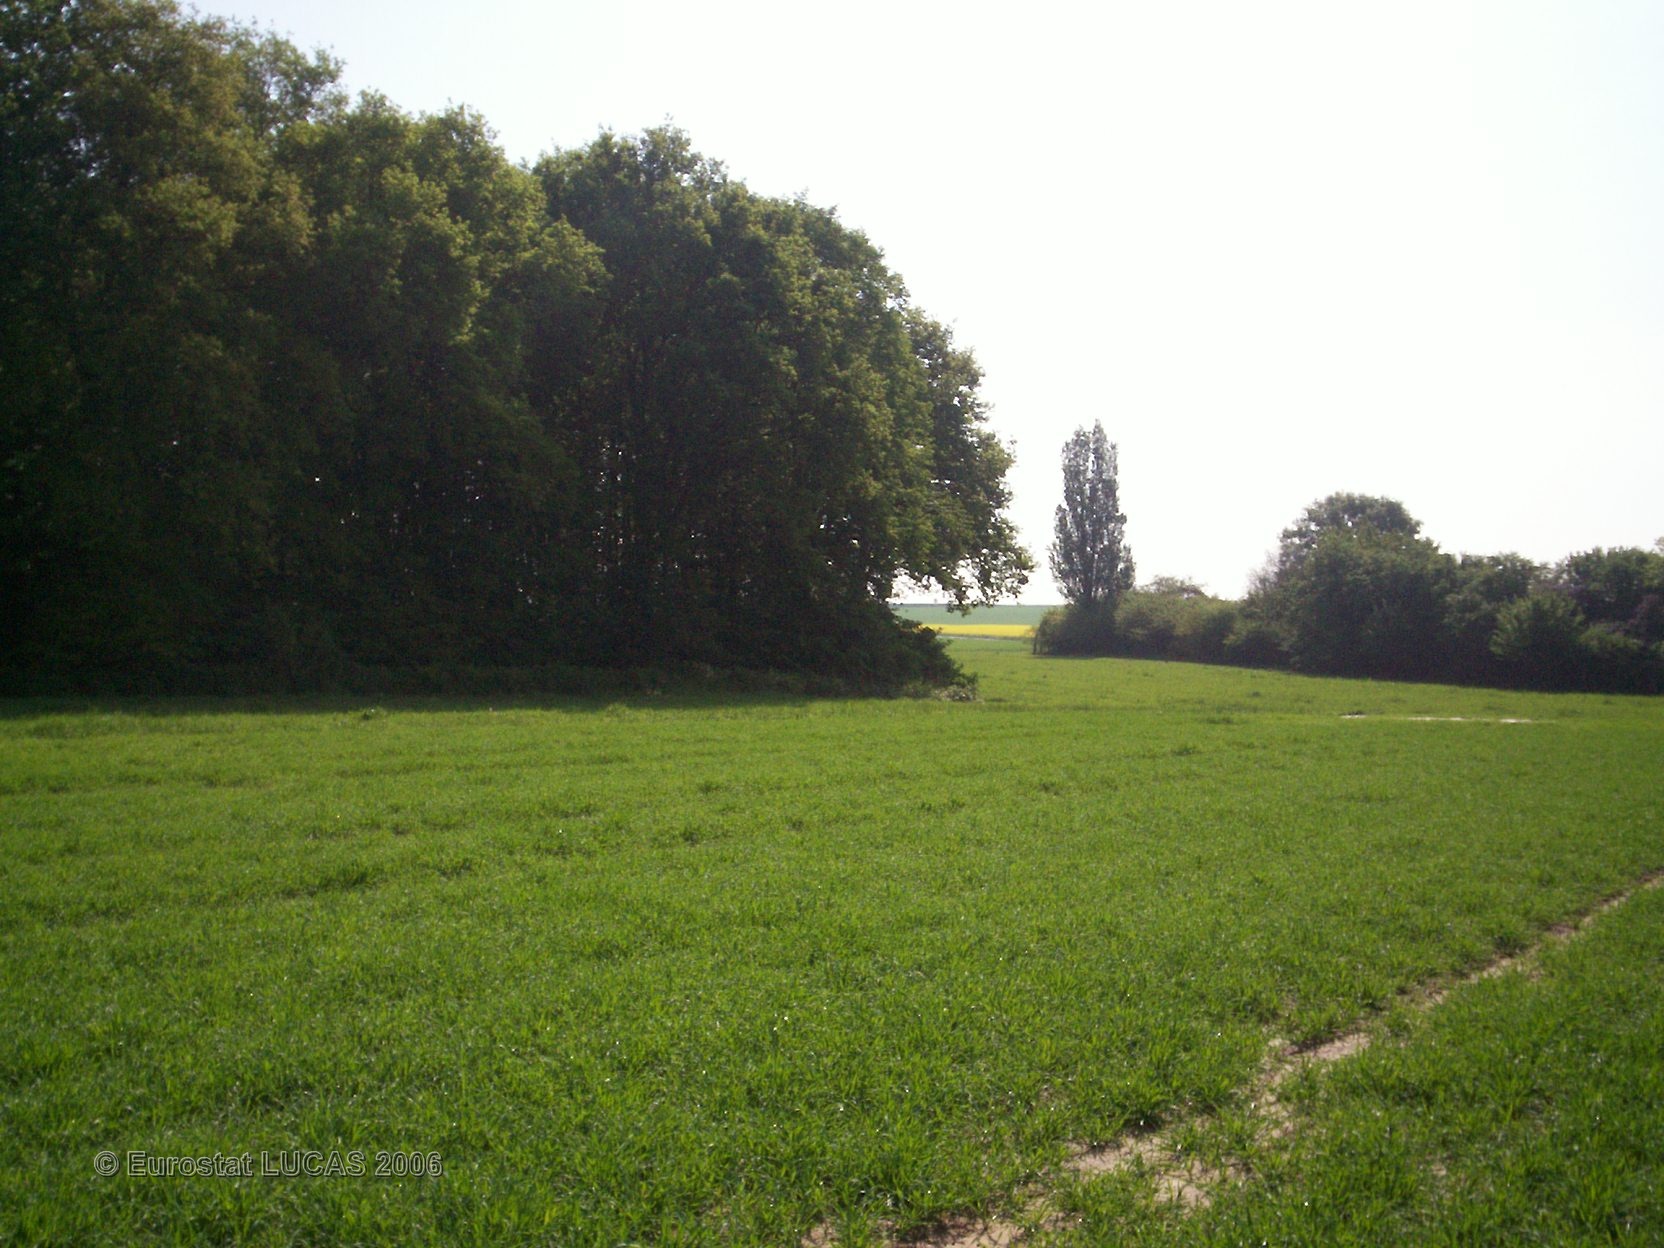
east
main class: Cropland
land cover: Barley
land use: Agriculture (excluding fallow land and kitchen gardens)
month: May
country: FR
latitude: 49.0523
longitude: 2.7789
